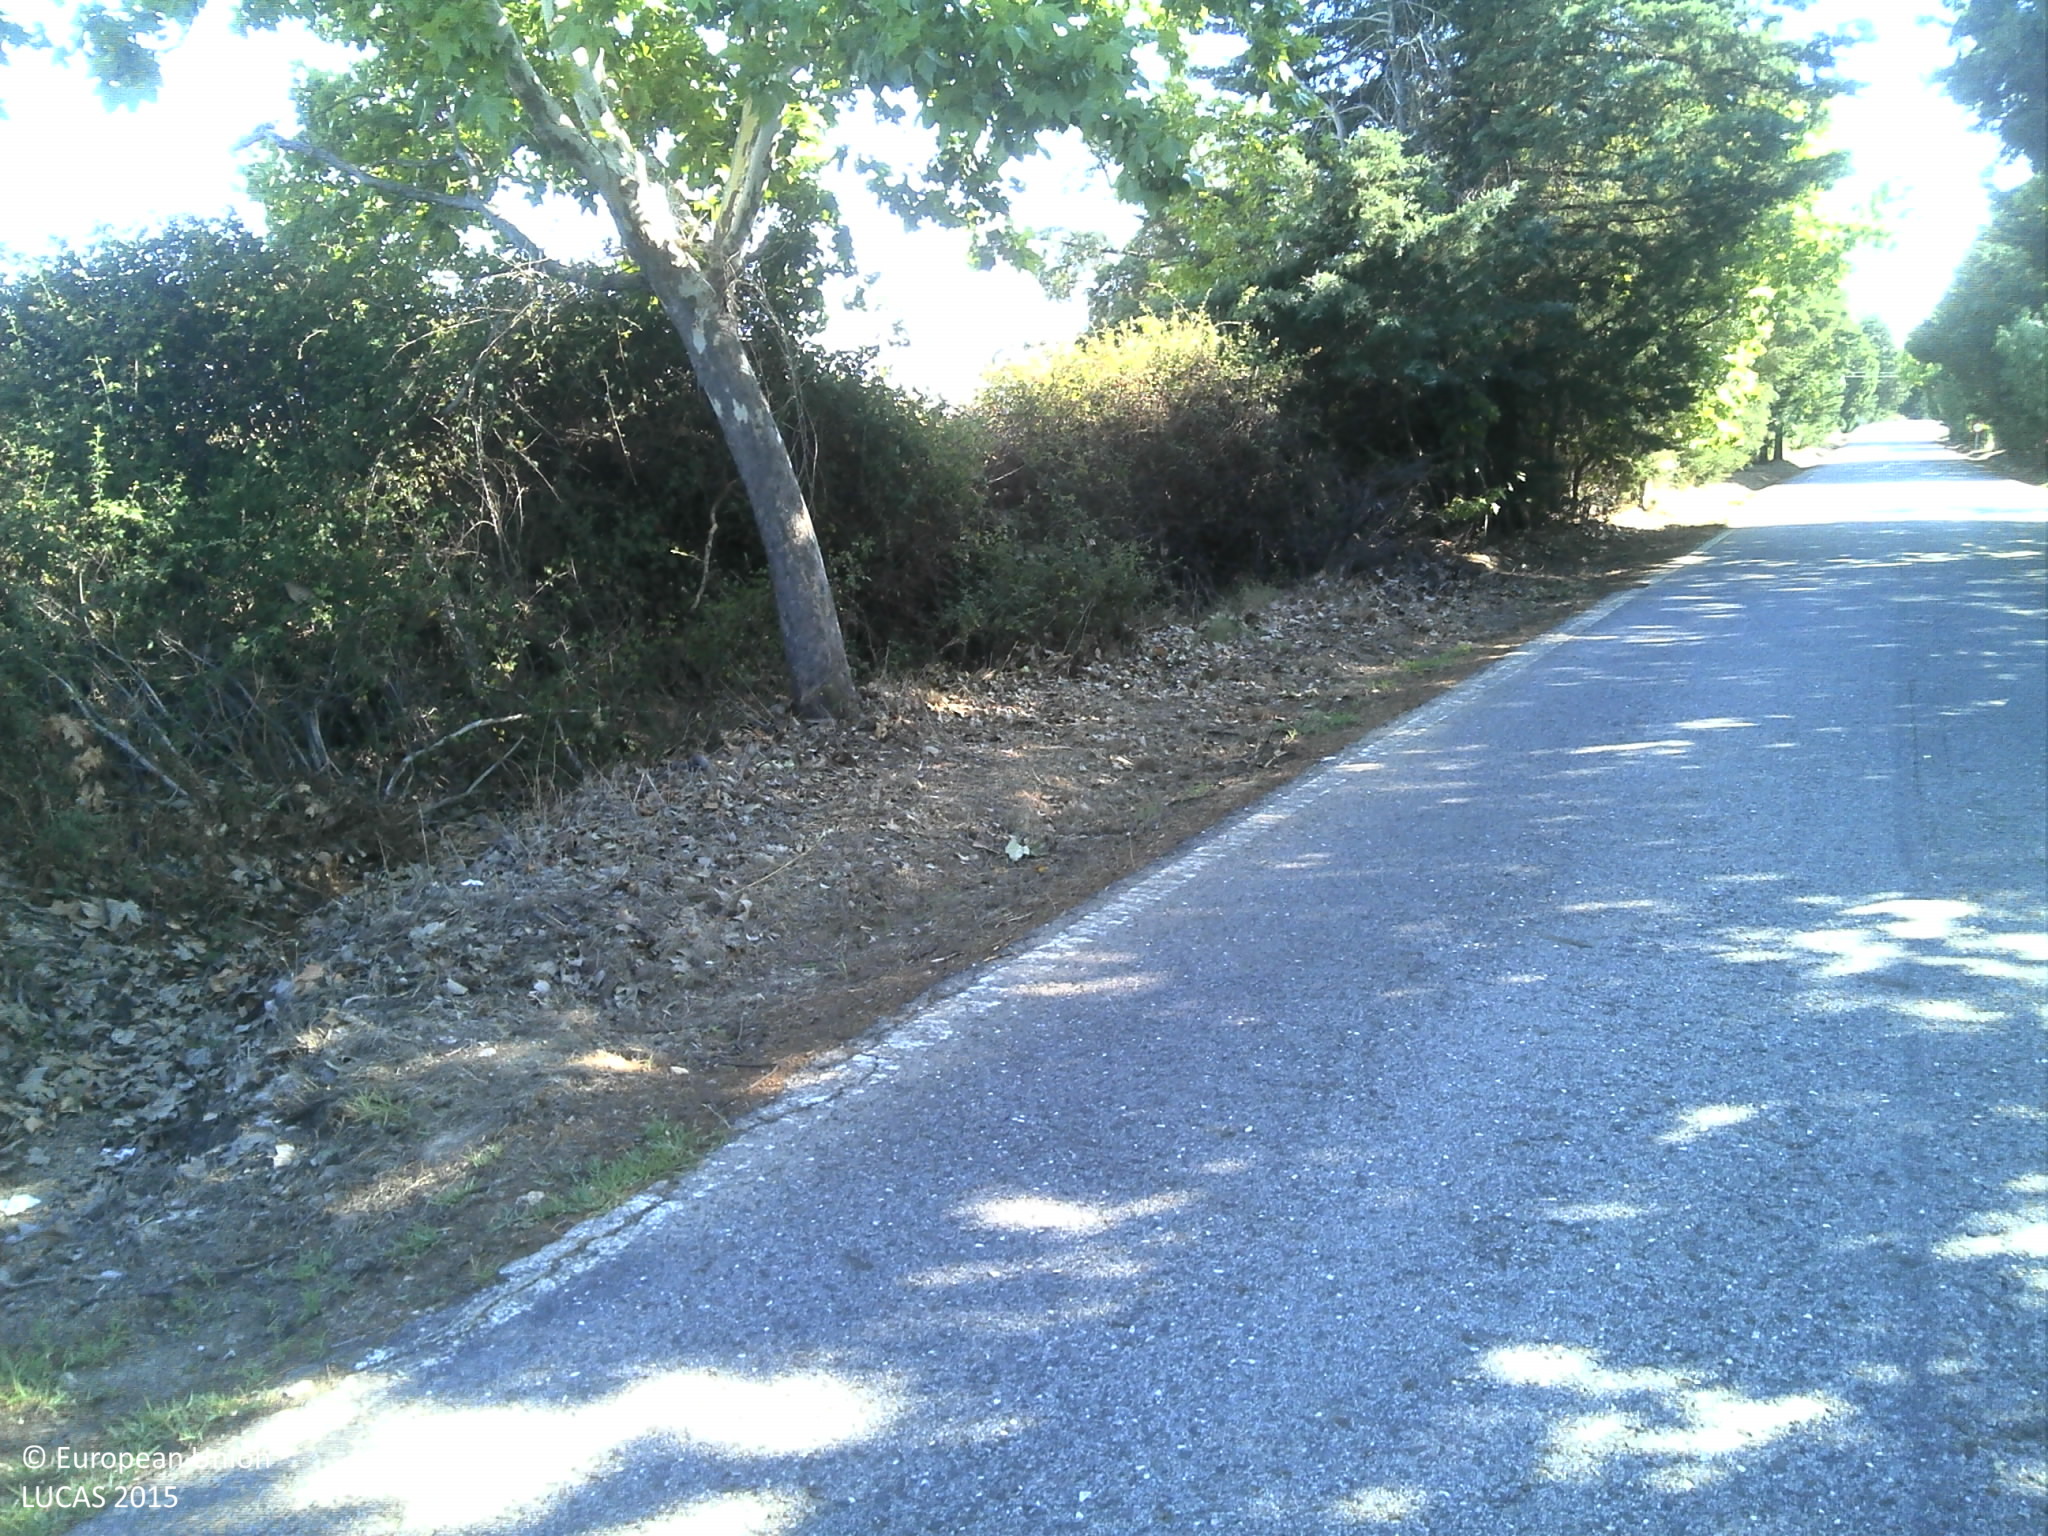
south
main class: Grassland
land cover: Grassland without tree/shrub cover
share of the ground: 50 - 75 %
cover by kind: herbaceous plants 70 %, unconsolidated bare surface 20 %
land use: Agriculture (excluding fallow land and kitchen gardens)
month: June
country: PT
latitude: 39.9442
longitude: -7.1452
